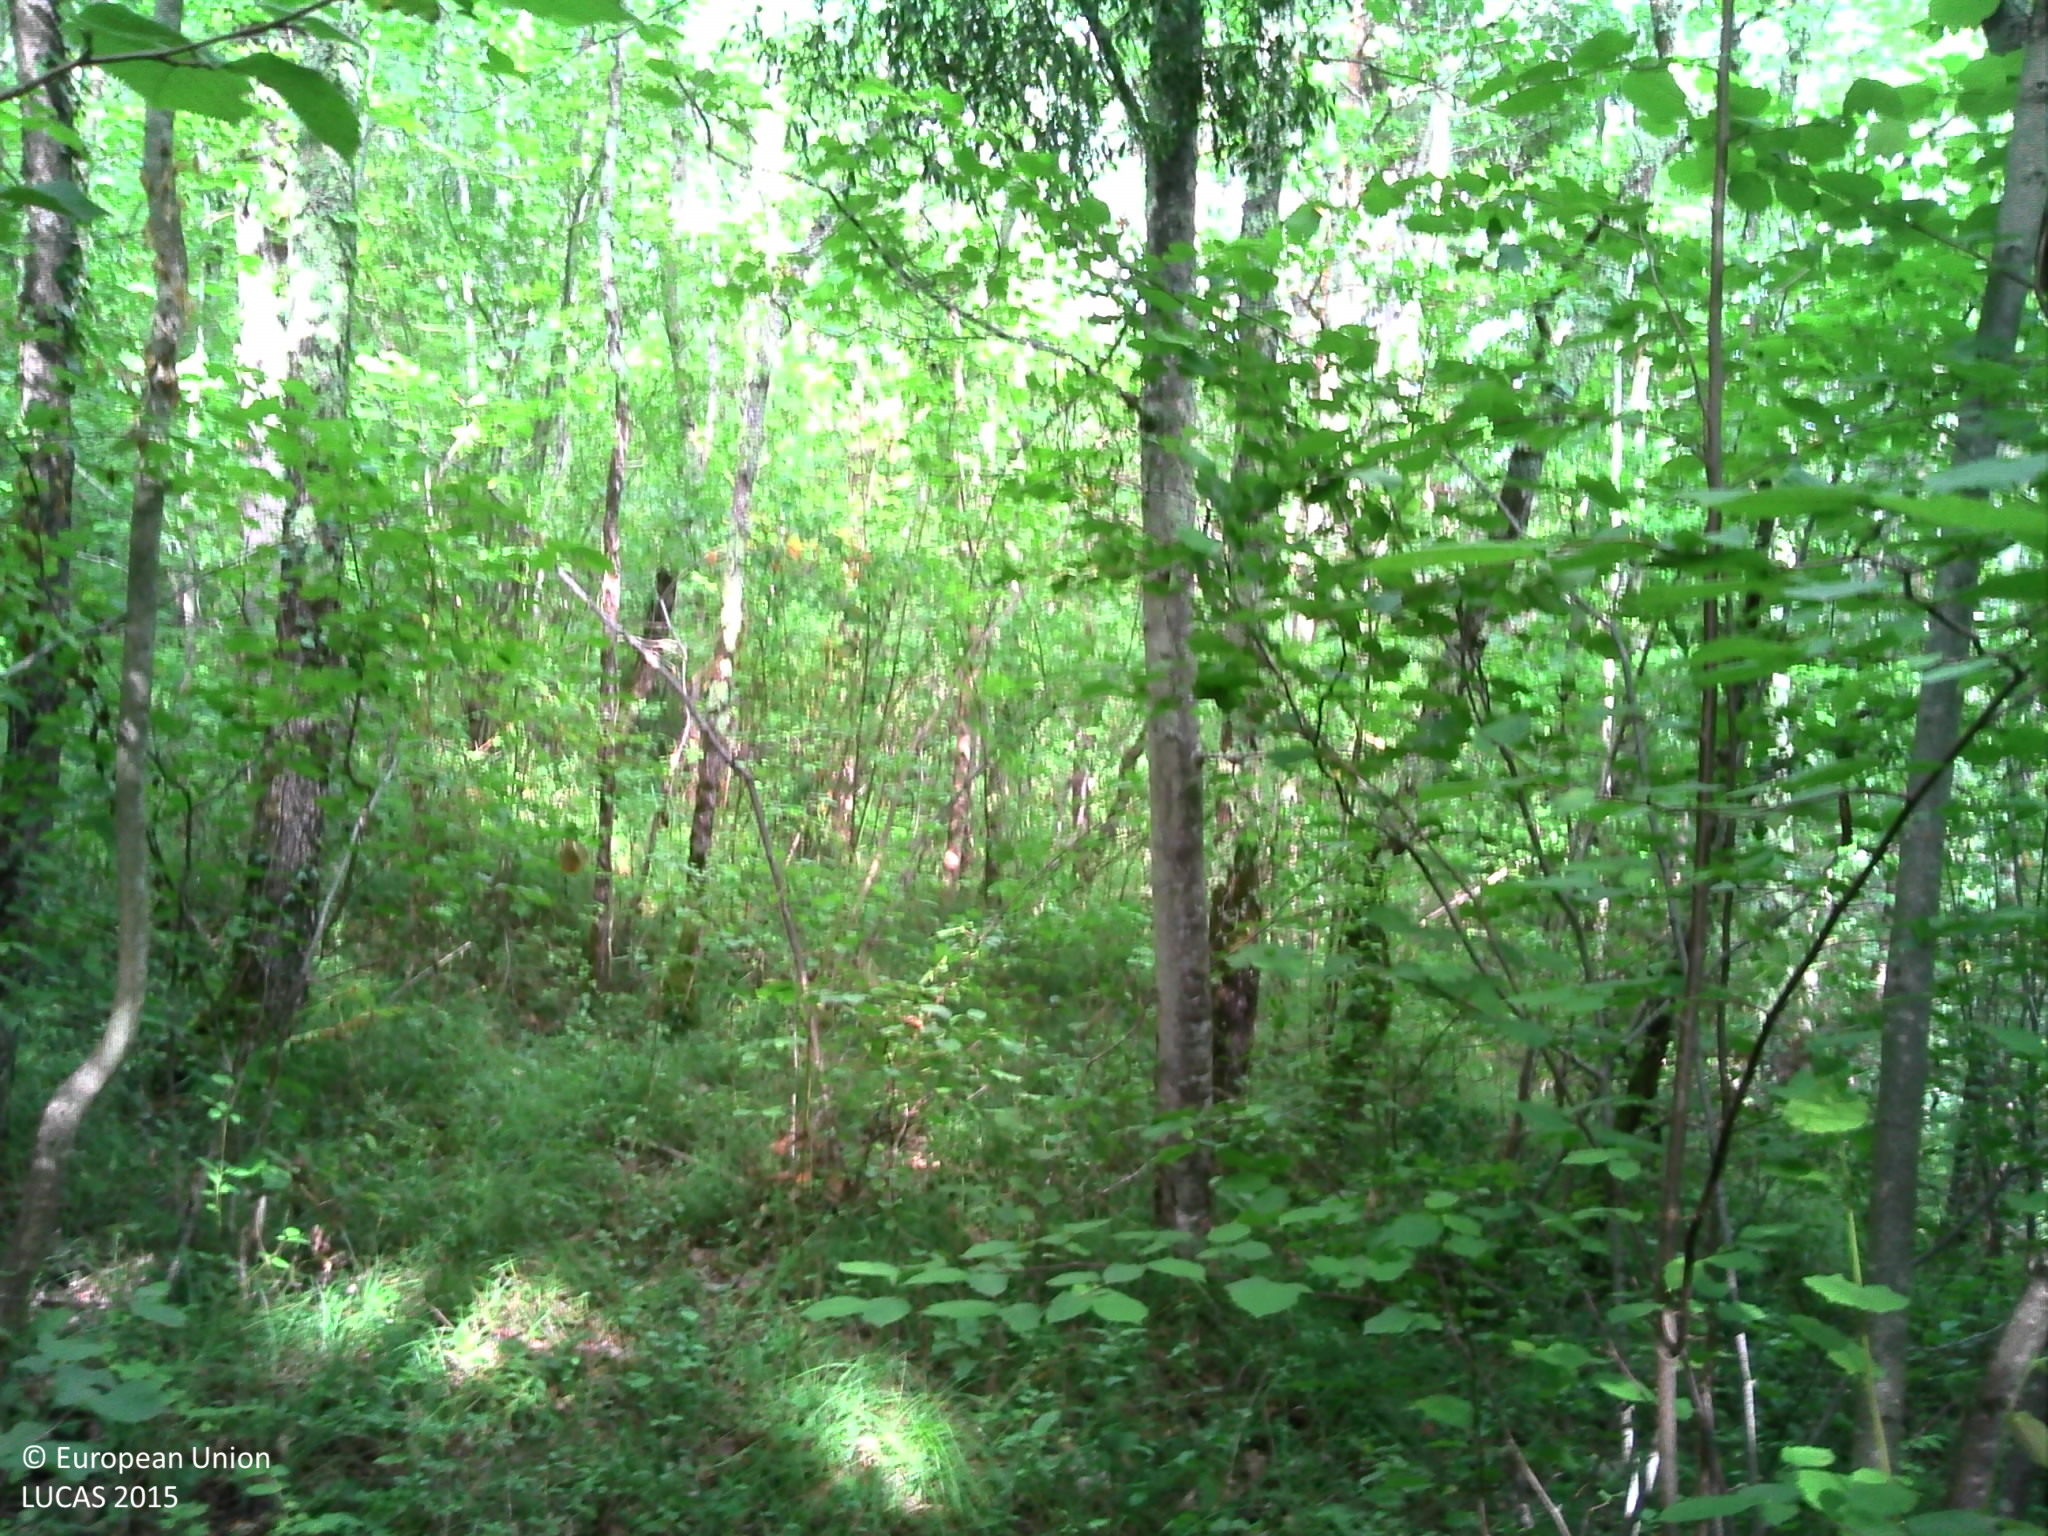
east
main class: Woodland
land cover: Broadleaved woodland
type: mesophytic deciduous forest
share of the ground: > 75 %
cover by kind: broadleaved forest trees 80 %, herbaceous plants 10 %, unconsolidated bare surface 10 %
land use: Semi-natural and natural areas not in use
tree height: > 5 m
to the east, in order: Broadleaved woodland; Fences; Spontaneously vegetated surfaces; Fences; Spontaneously vegetated surfaces; Grassland without tree/shrub cover; Fences; Grassland without tree/shrub cover; Fences; Spontaneously vegetated surfaces; Grassland without tree/shrub cover; Tracks; Grassland without tree/shrub cover; Broadleaved woodland
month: August
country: FR
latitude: 42.9806
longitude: 1.6560
